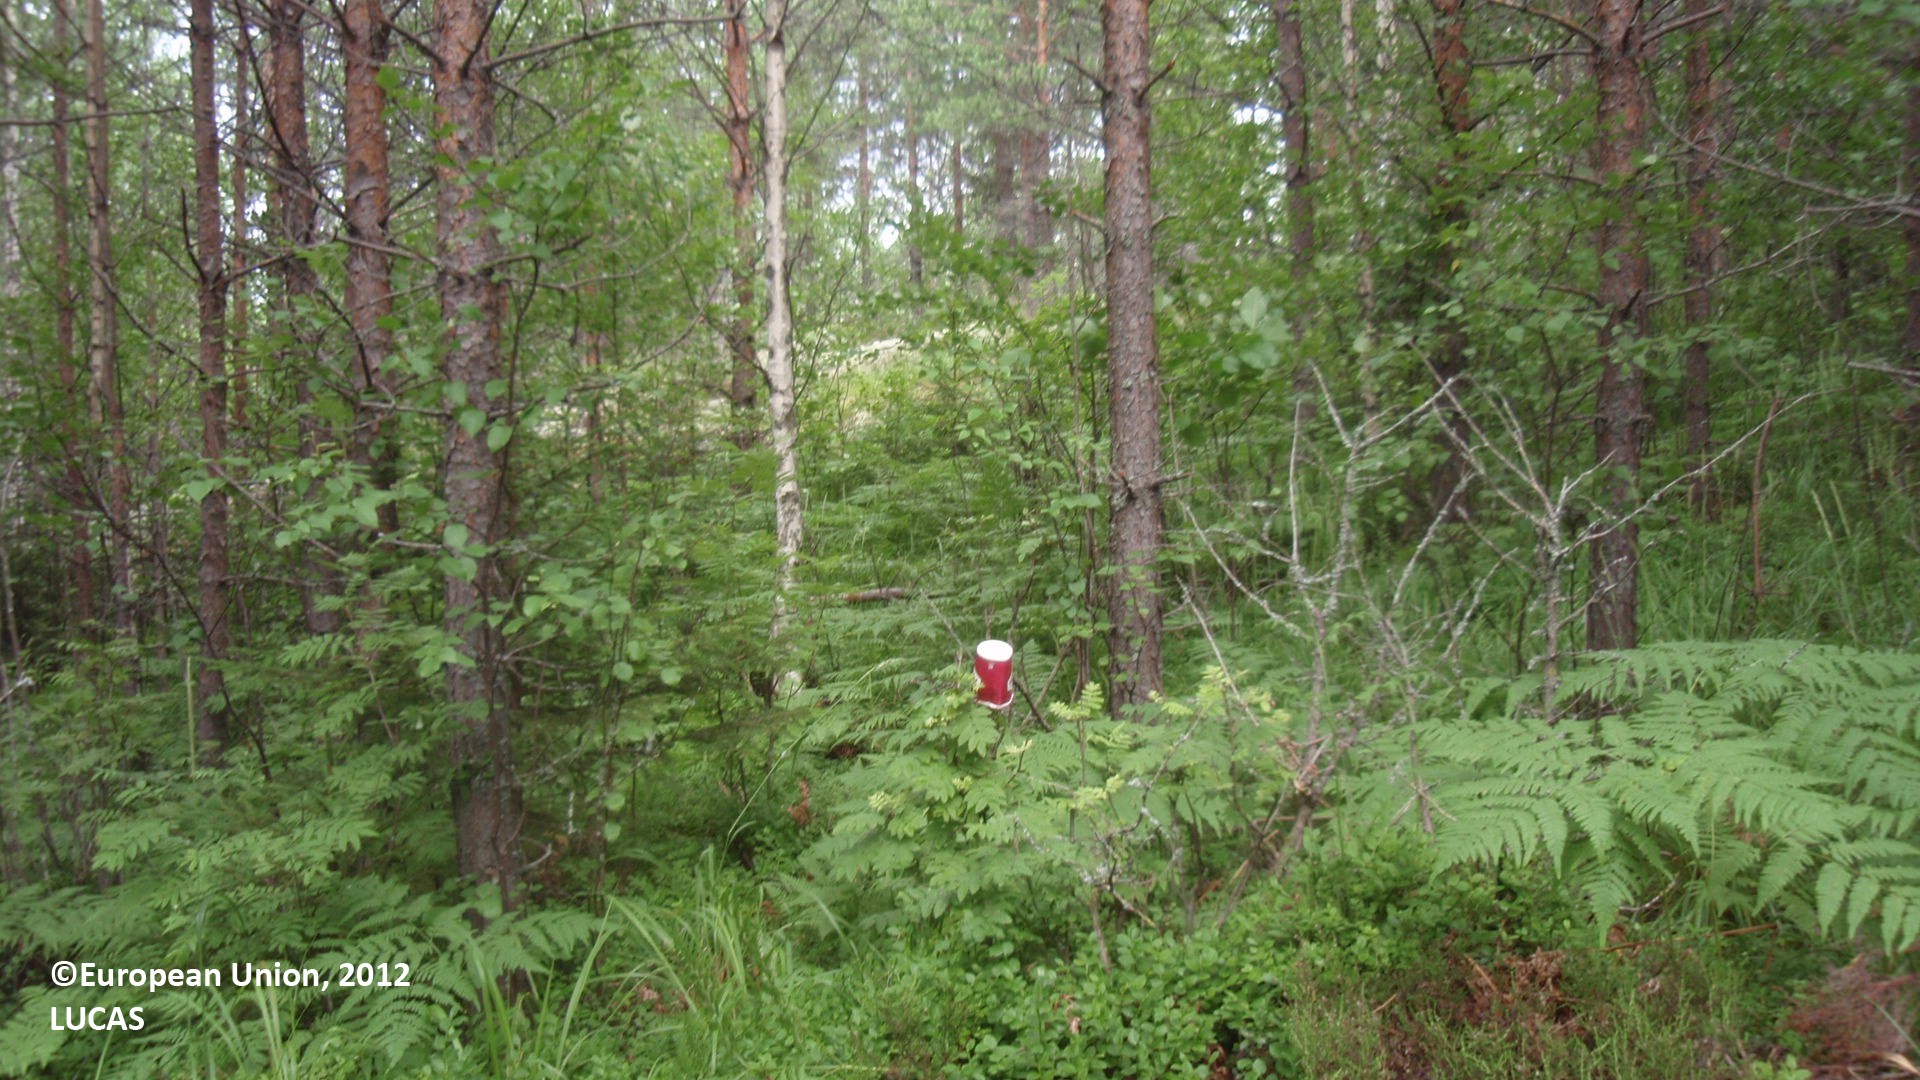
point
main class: Woodland
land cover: Pine dominated mixed woodland
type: boreal forest
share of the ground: 50 - 75 %
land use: Forestry
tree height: > 5 m
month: July
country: FI
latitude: 61.4487
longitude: 28.4994
